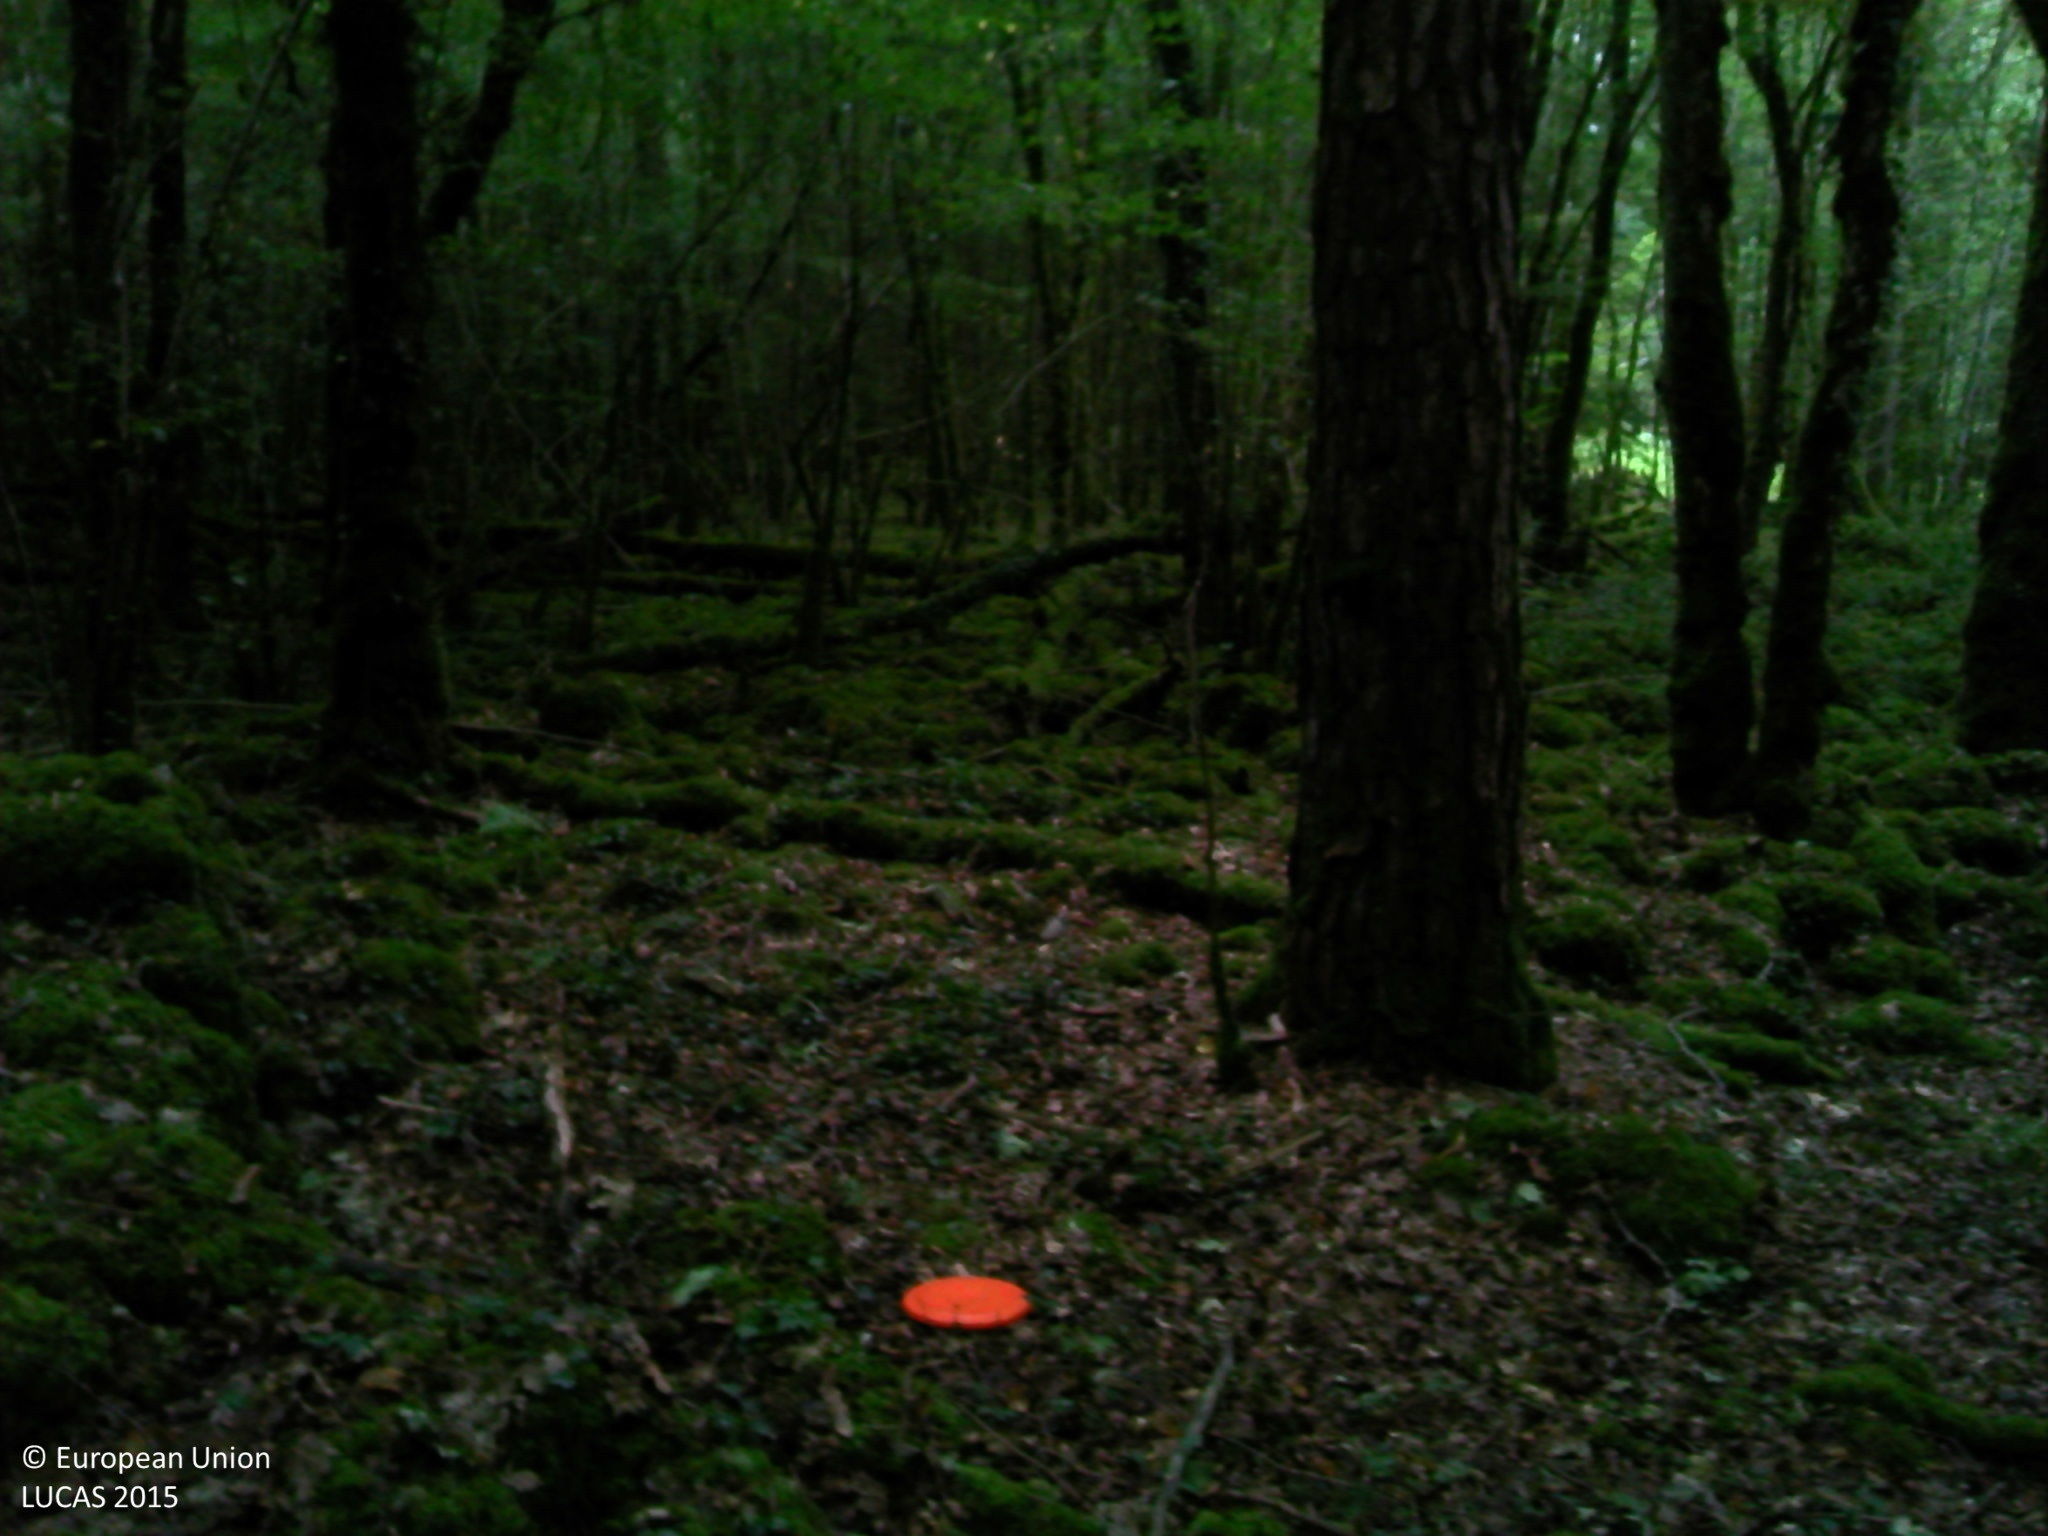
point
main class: Woodland
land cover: Pine dominated mixed woodland
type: hemiboreal forest and nemoral coniferous forest and mixed broadleaved-coniferous forest
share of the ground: > 75 %
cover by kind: coniferous forest trees 45 %, broadleaved forest trees 45 %, herbaceous plants 5 %, lichens and mosses 5 %
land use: Forestry
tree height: > 5 m
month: August
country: FR
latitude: 47.7510
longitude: 4.6501
